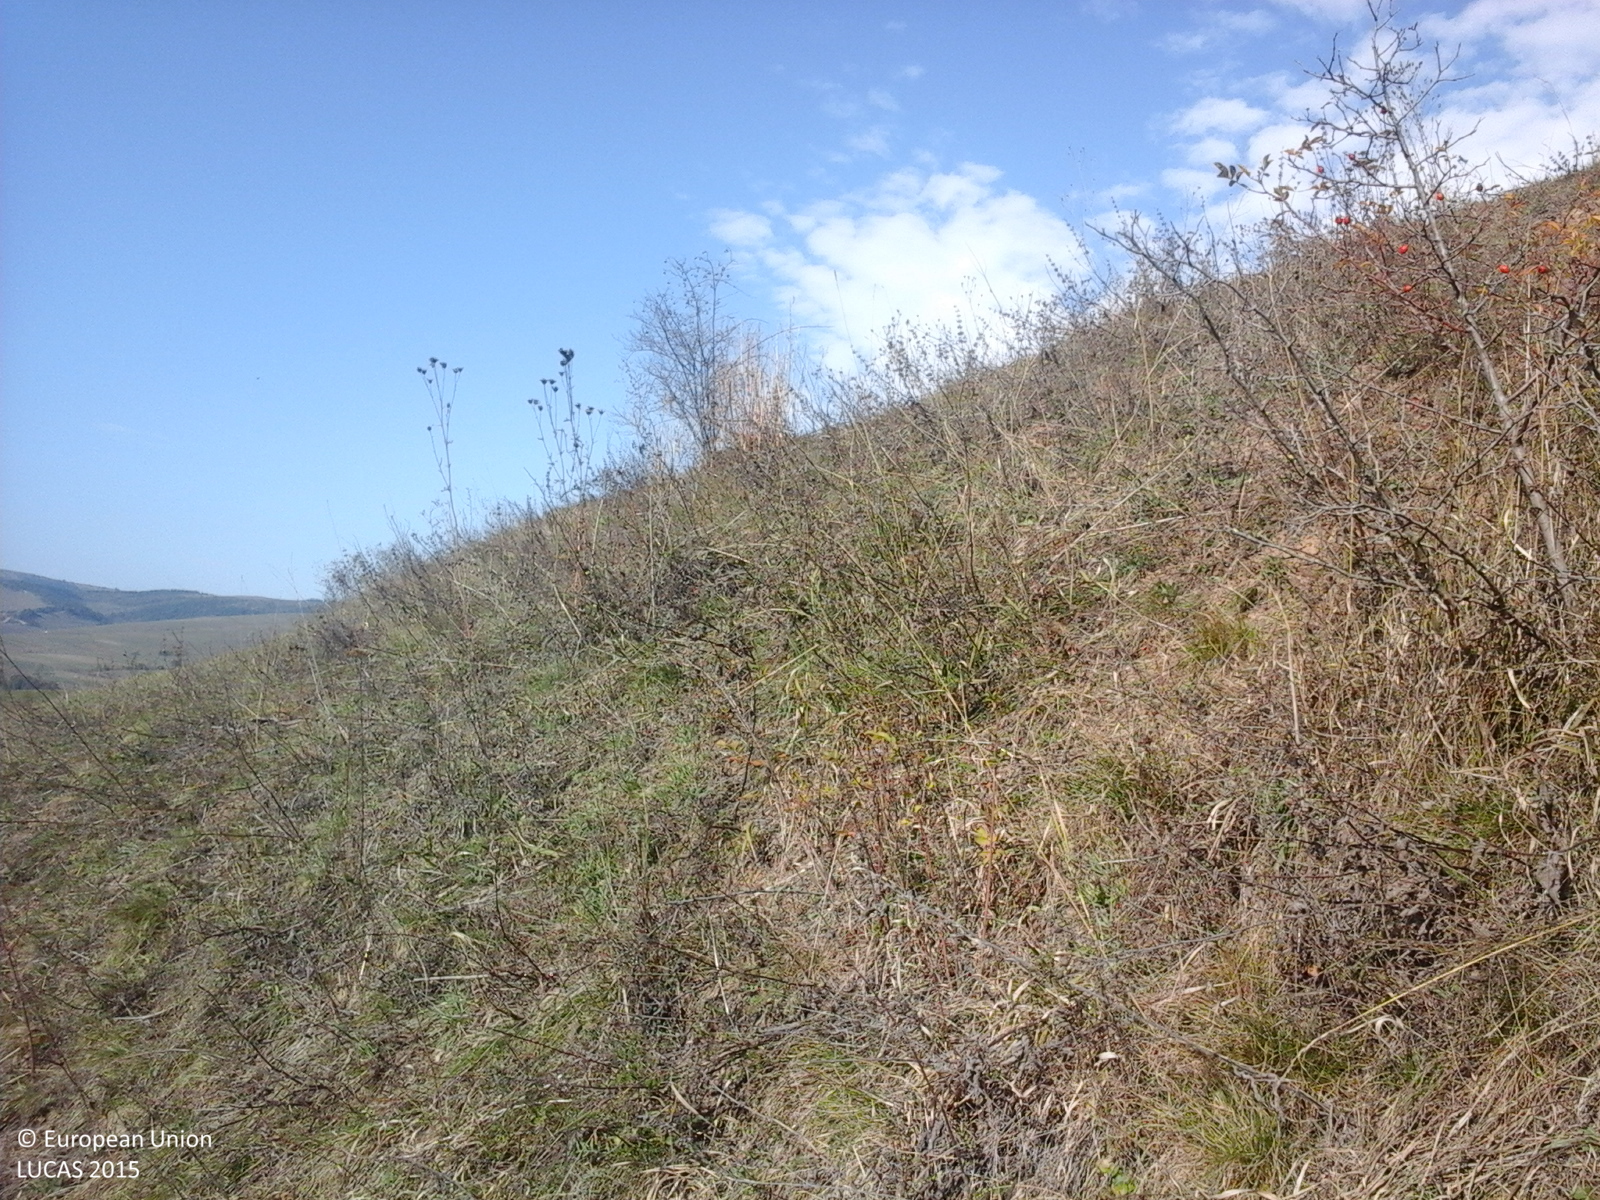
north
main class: Grassland
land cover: Spontaneously vegetated surfaces
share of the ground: > 75 %
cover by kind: herbaceous plants 100 %
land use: Fallow land
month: October
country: RO
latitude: 46.3324
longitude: 25.9806
